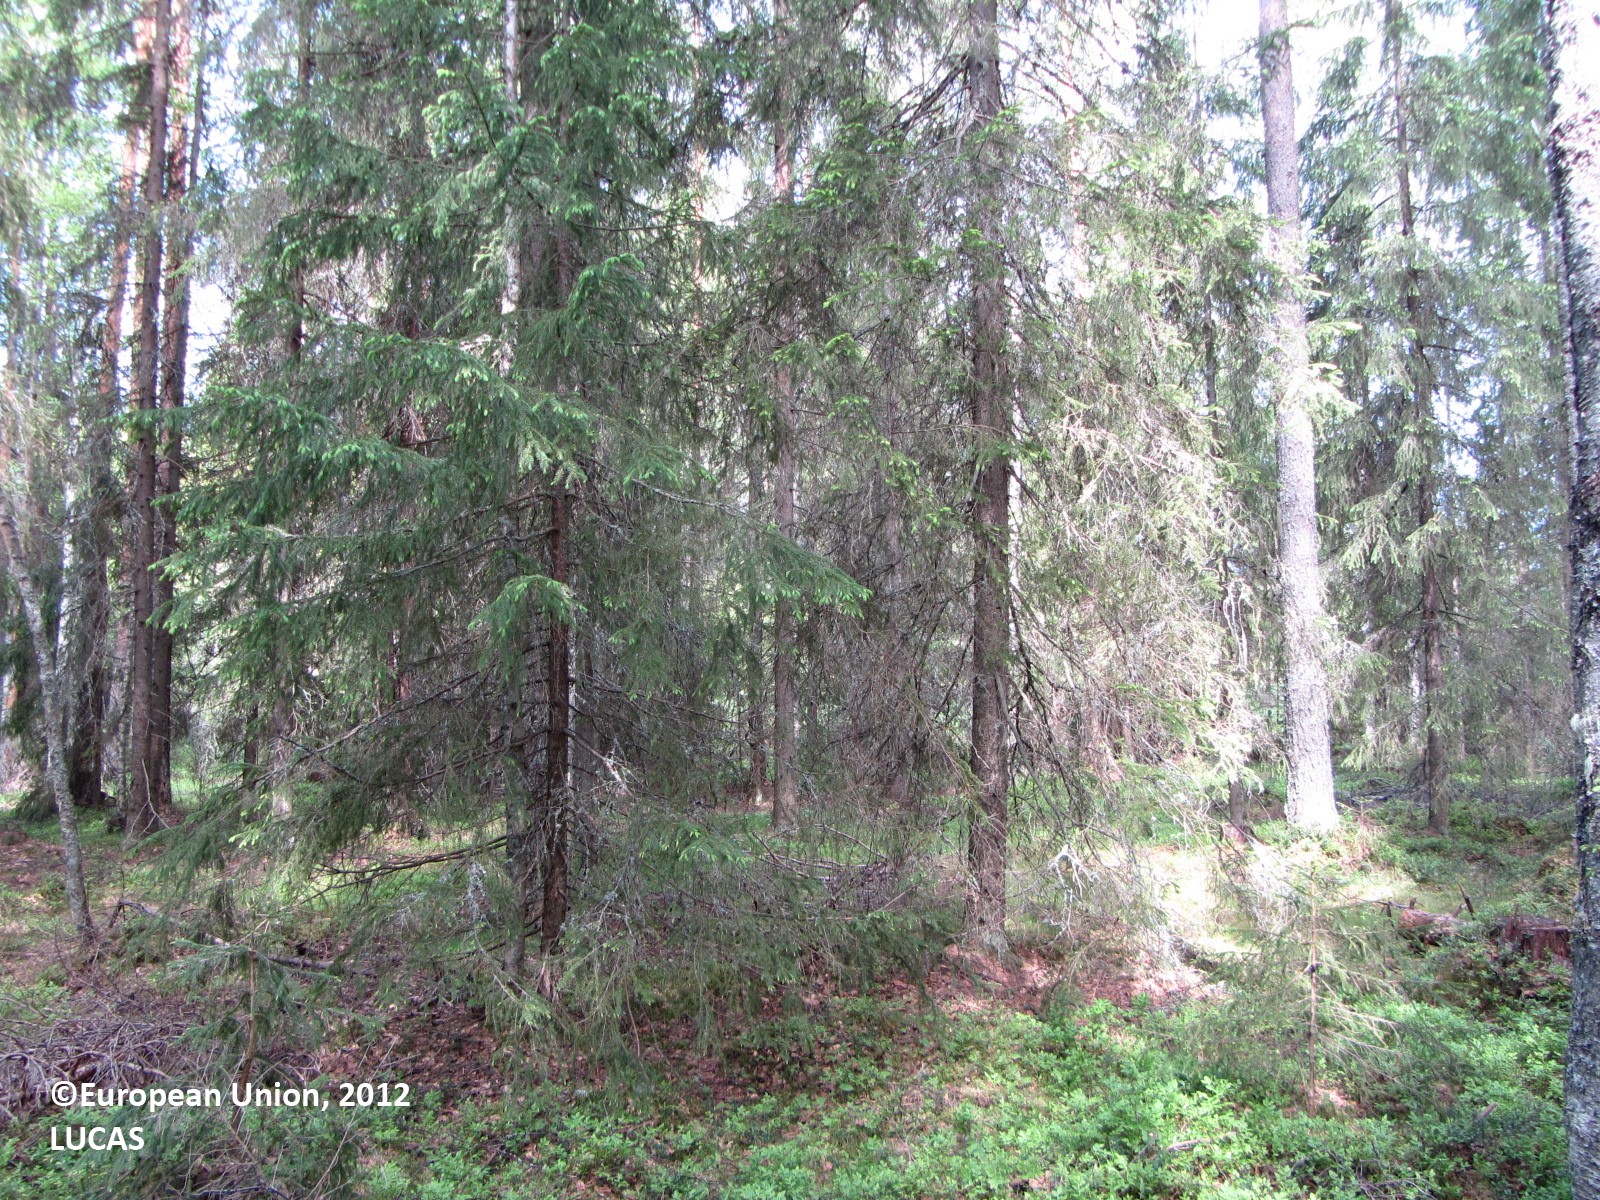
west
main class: Woodland
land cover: Spruce dominated mixed woodland
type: boreal forest
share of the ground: > 75 %
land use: Forestry
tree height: > 5 m
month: June
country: FI
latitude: 61.8034
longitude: 24.9607
